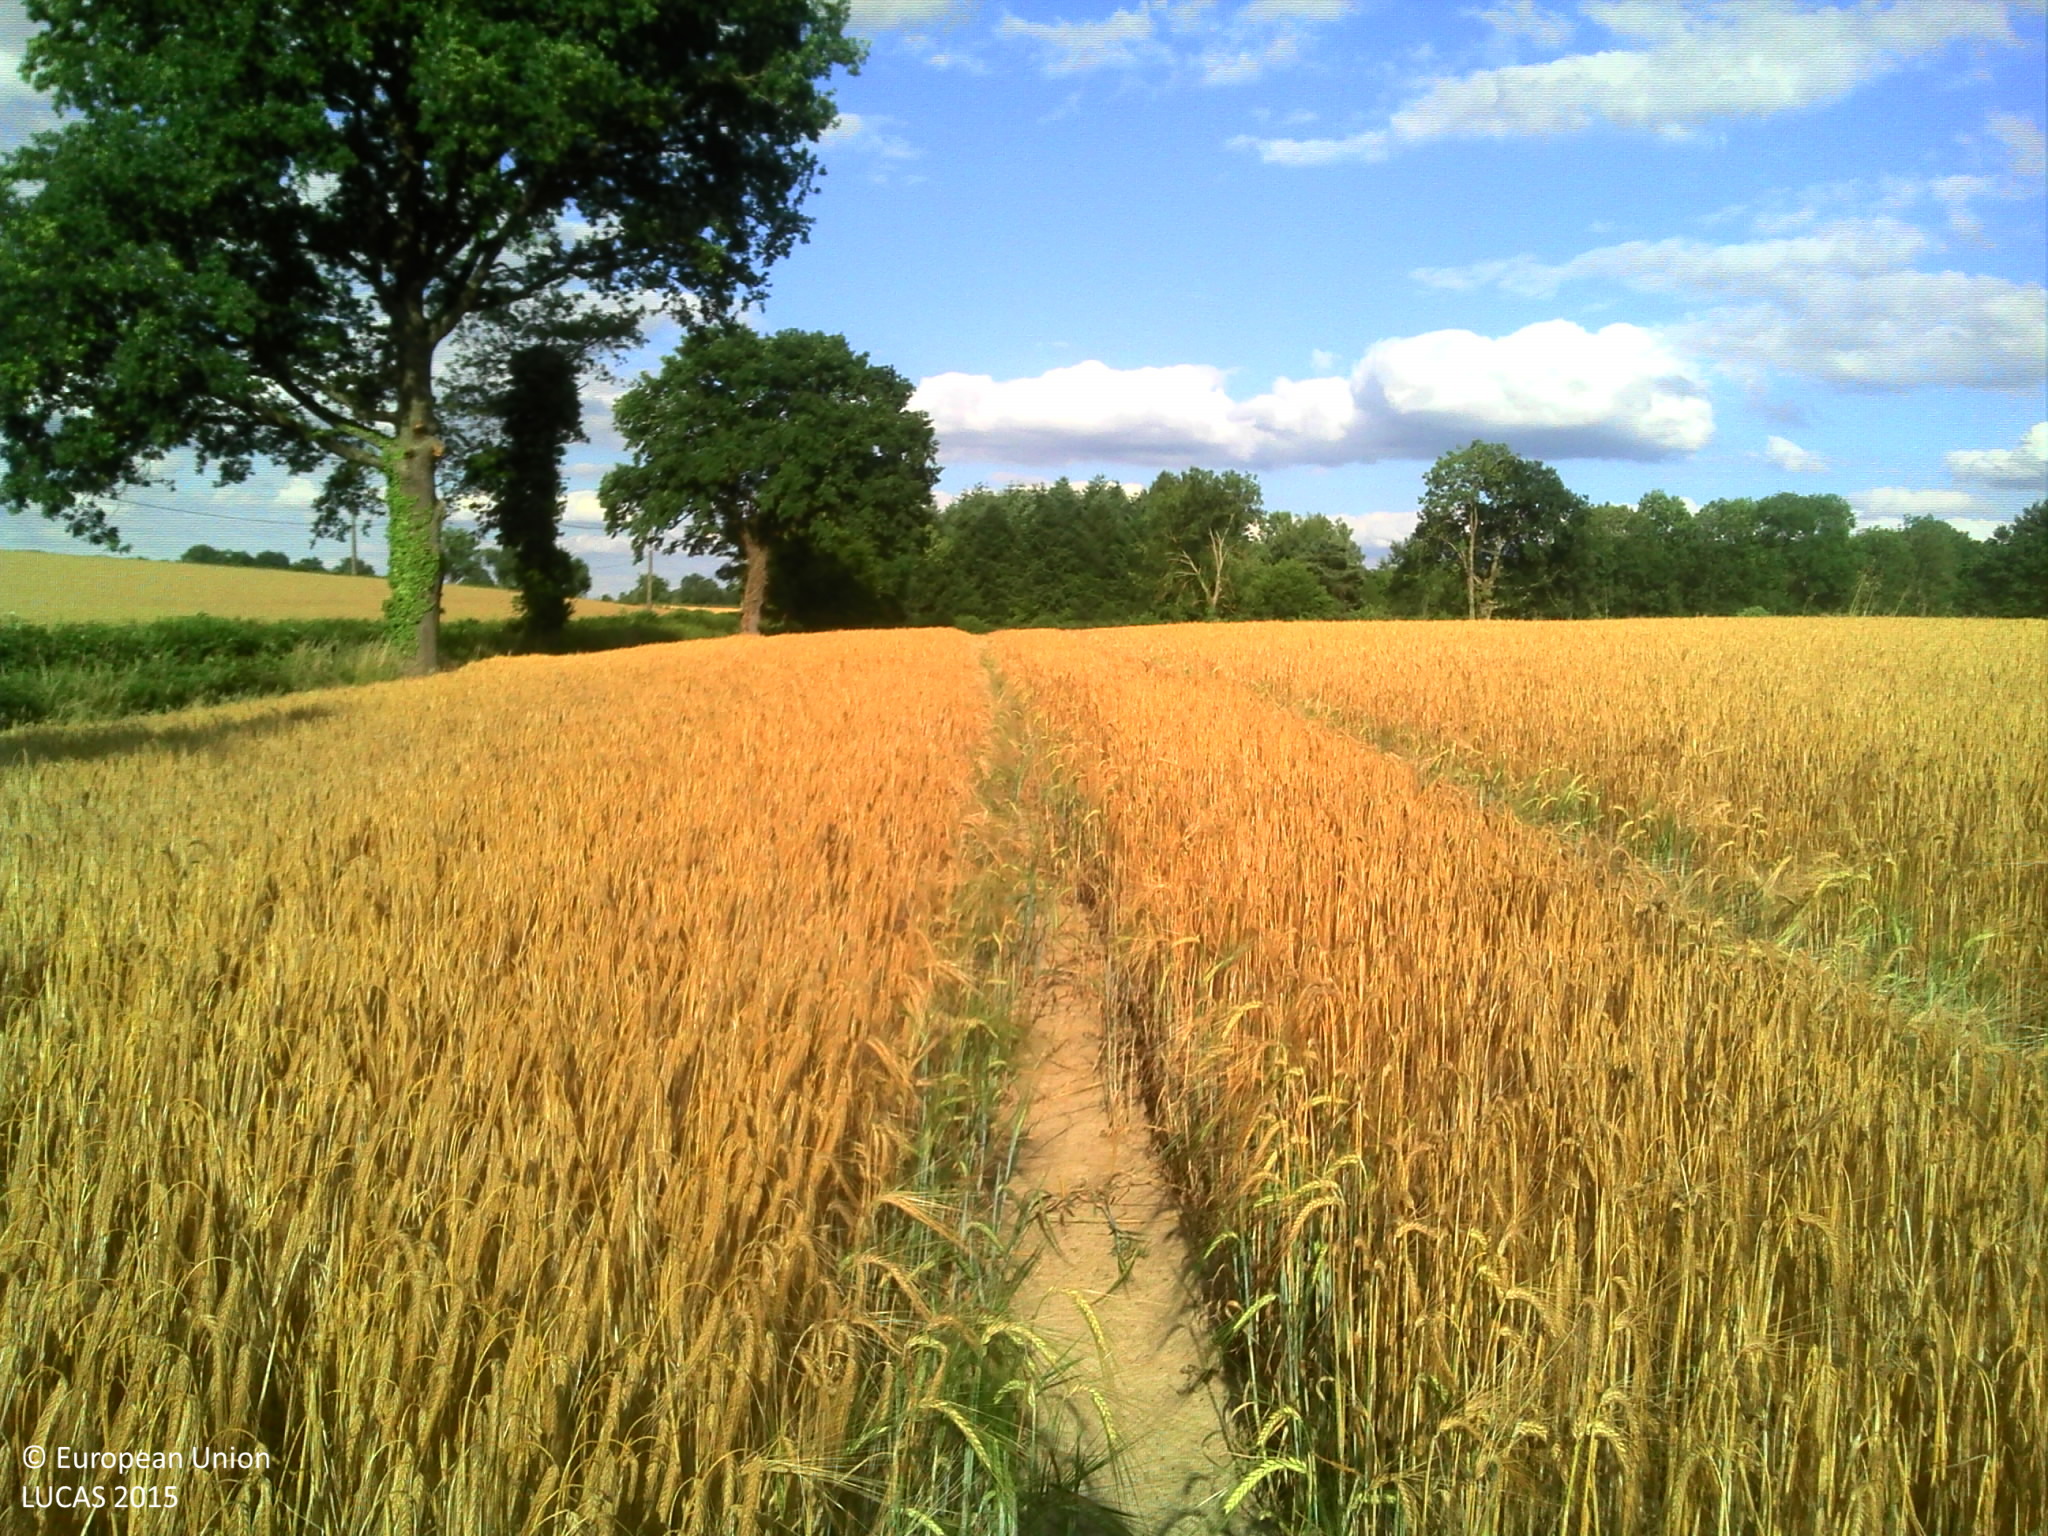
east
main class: Cropland
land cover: Barley
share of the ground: > 75 %
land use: Agriculture (excluding fallow land and kitchen gardens)
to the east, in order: Barley; Fences; Abandoned hedges; Grassland without tree/shrub cover; Fences; Groves; Grassland with sparse tree/shrub cover
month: June
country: FR
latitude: 46.4220
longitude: 4.0803
